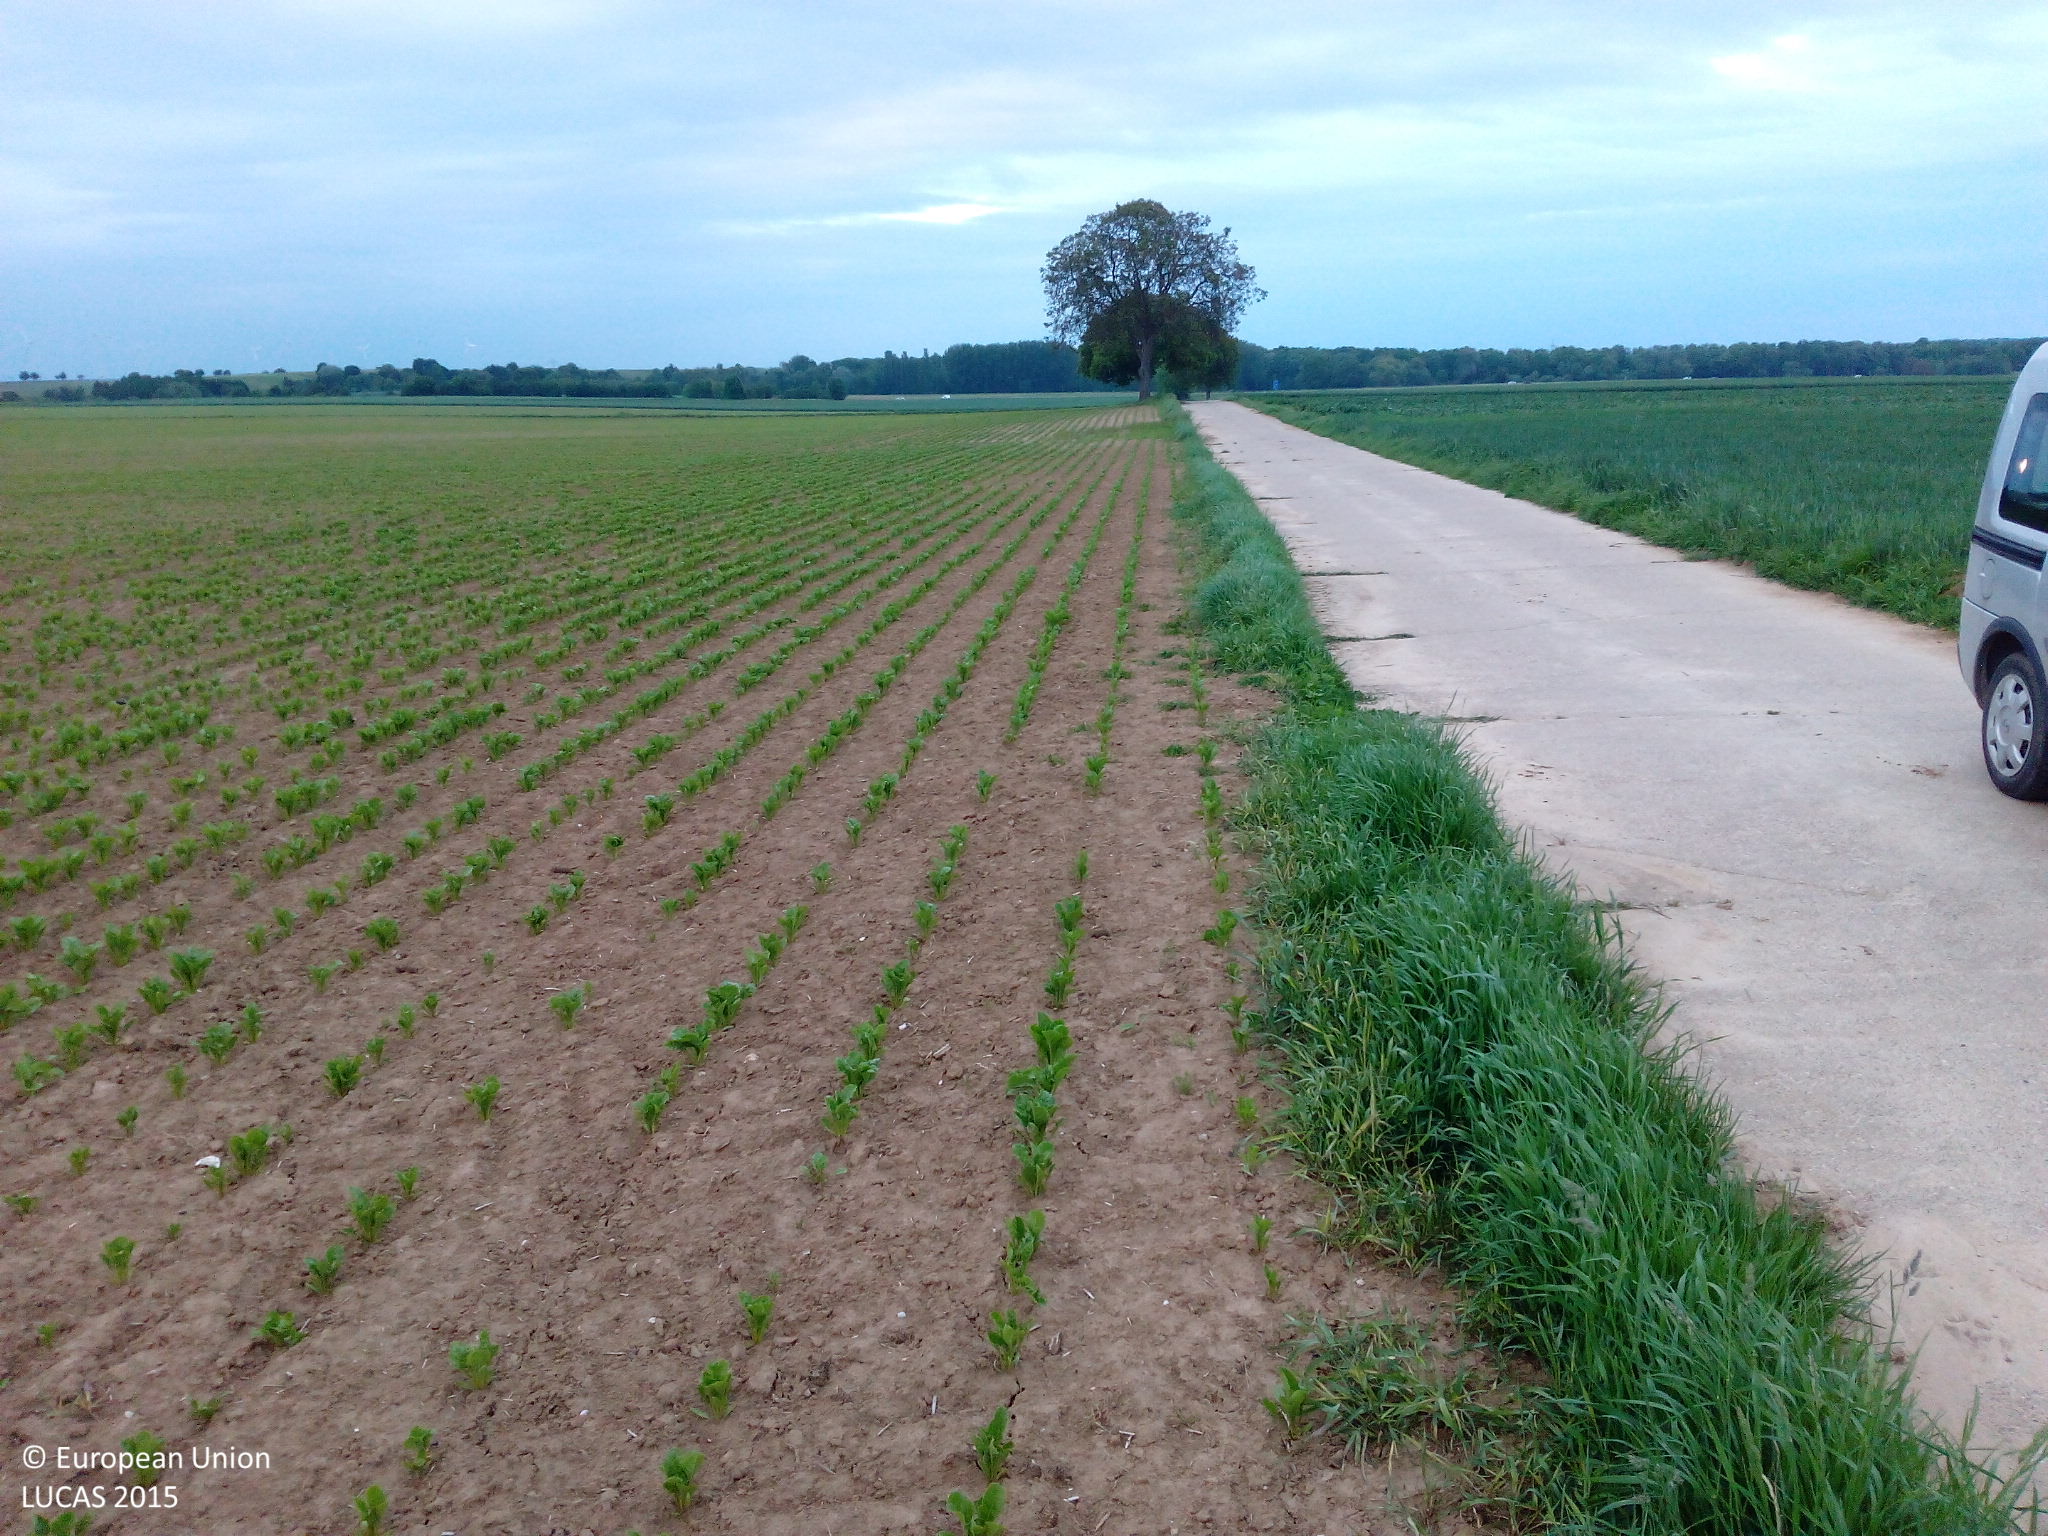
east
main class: Cropland
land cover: Sugar beet
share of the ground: < 10 %
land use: Agriculture (excluding fallow land and kitchen gardens)
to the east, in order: Sugar beet; Paved roads, cycling and walking lanes; Common wheat; Paved roads, cycling and walking lanes; Maize
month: May
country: DE
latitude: 49.1438
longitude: 8.1499
